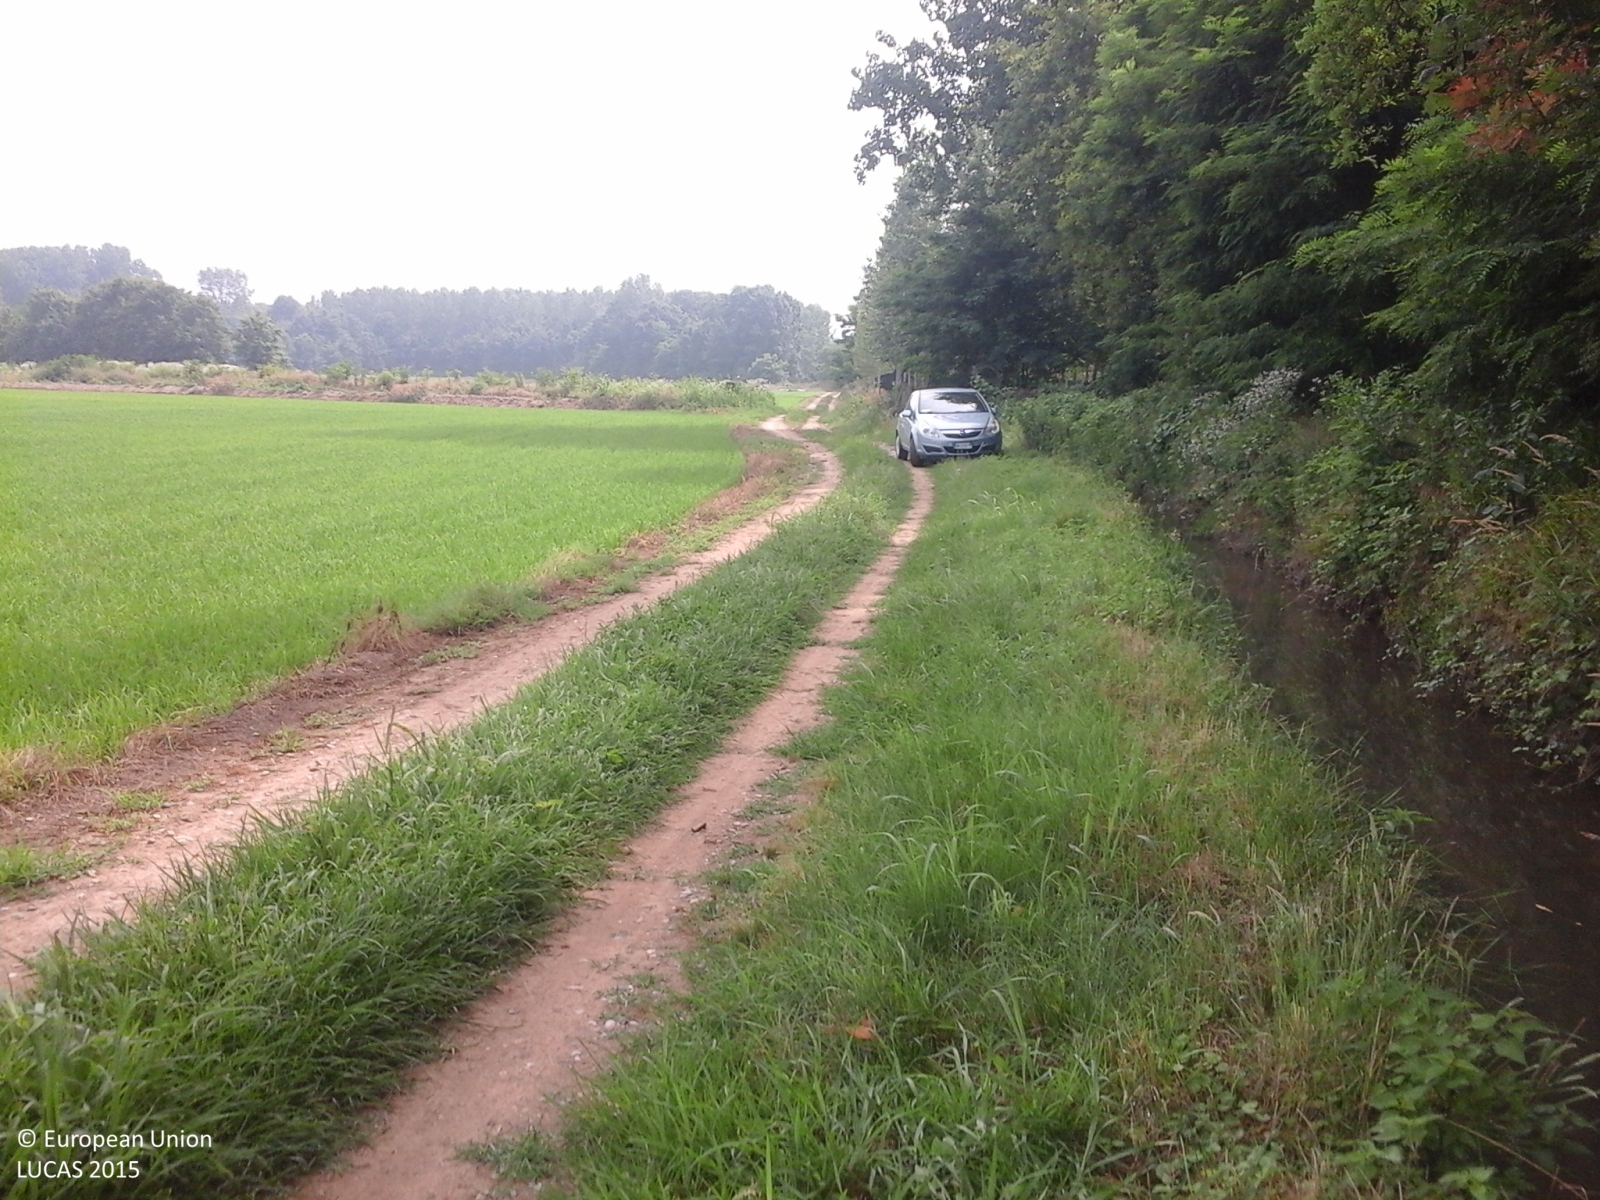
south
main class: Woodland
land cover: Broadleaved woodland
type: thermophilous deciduous forest
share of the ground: > 75 %
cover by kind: broadleaved forest trees 100 %
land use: Forestry
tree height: > 5 m
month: June
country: IT
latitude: 45.1911
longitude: 8.7930
